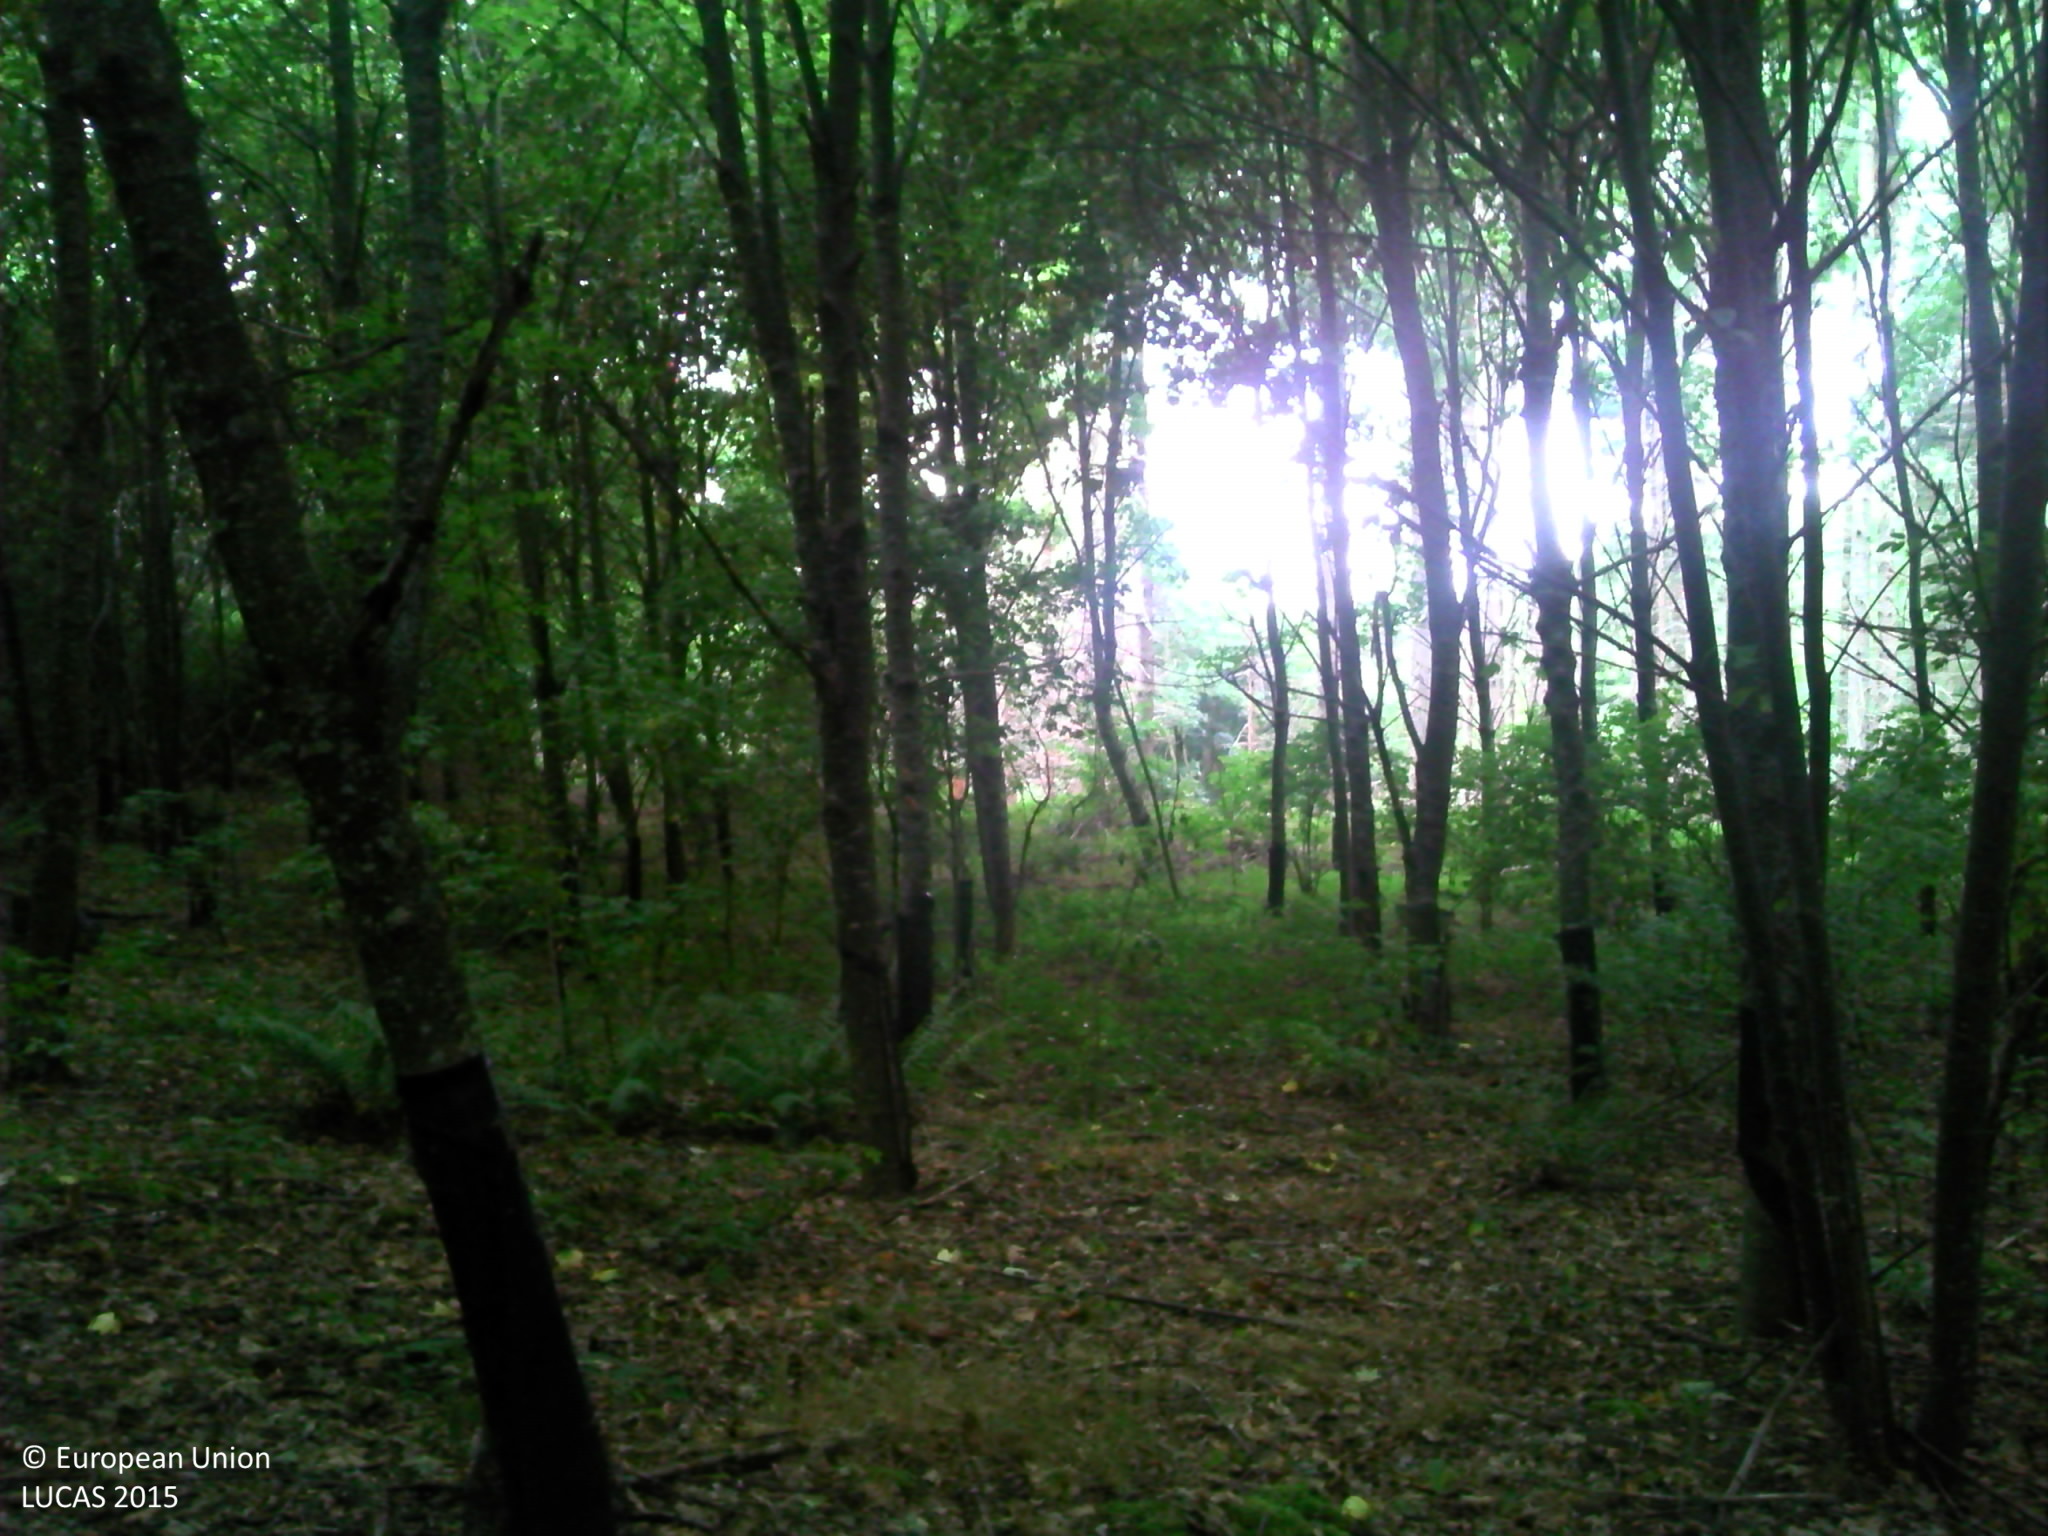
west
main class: Woodland
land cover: Broadleaved woodland
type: exotic forest
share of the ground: > 75 %
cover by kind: broadleaved forest trees 90 %, herbaceous plants 5 %
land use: Forestry
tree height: > 5 m
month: August
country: FR
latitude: 44.9119
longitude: 4.5462
